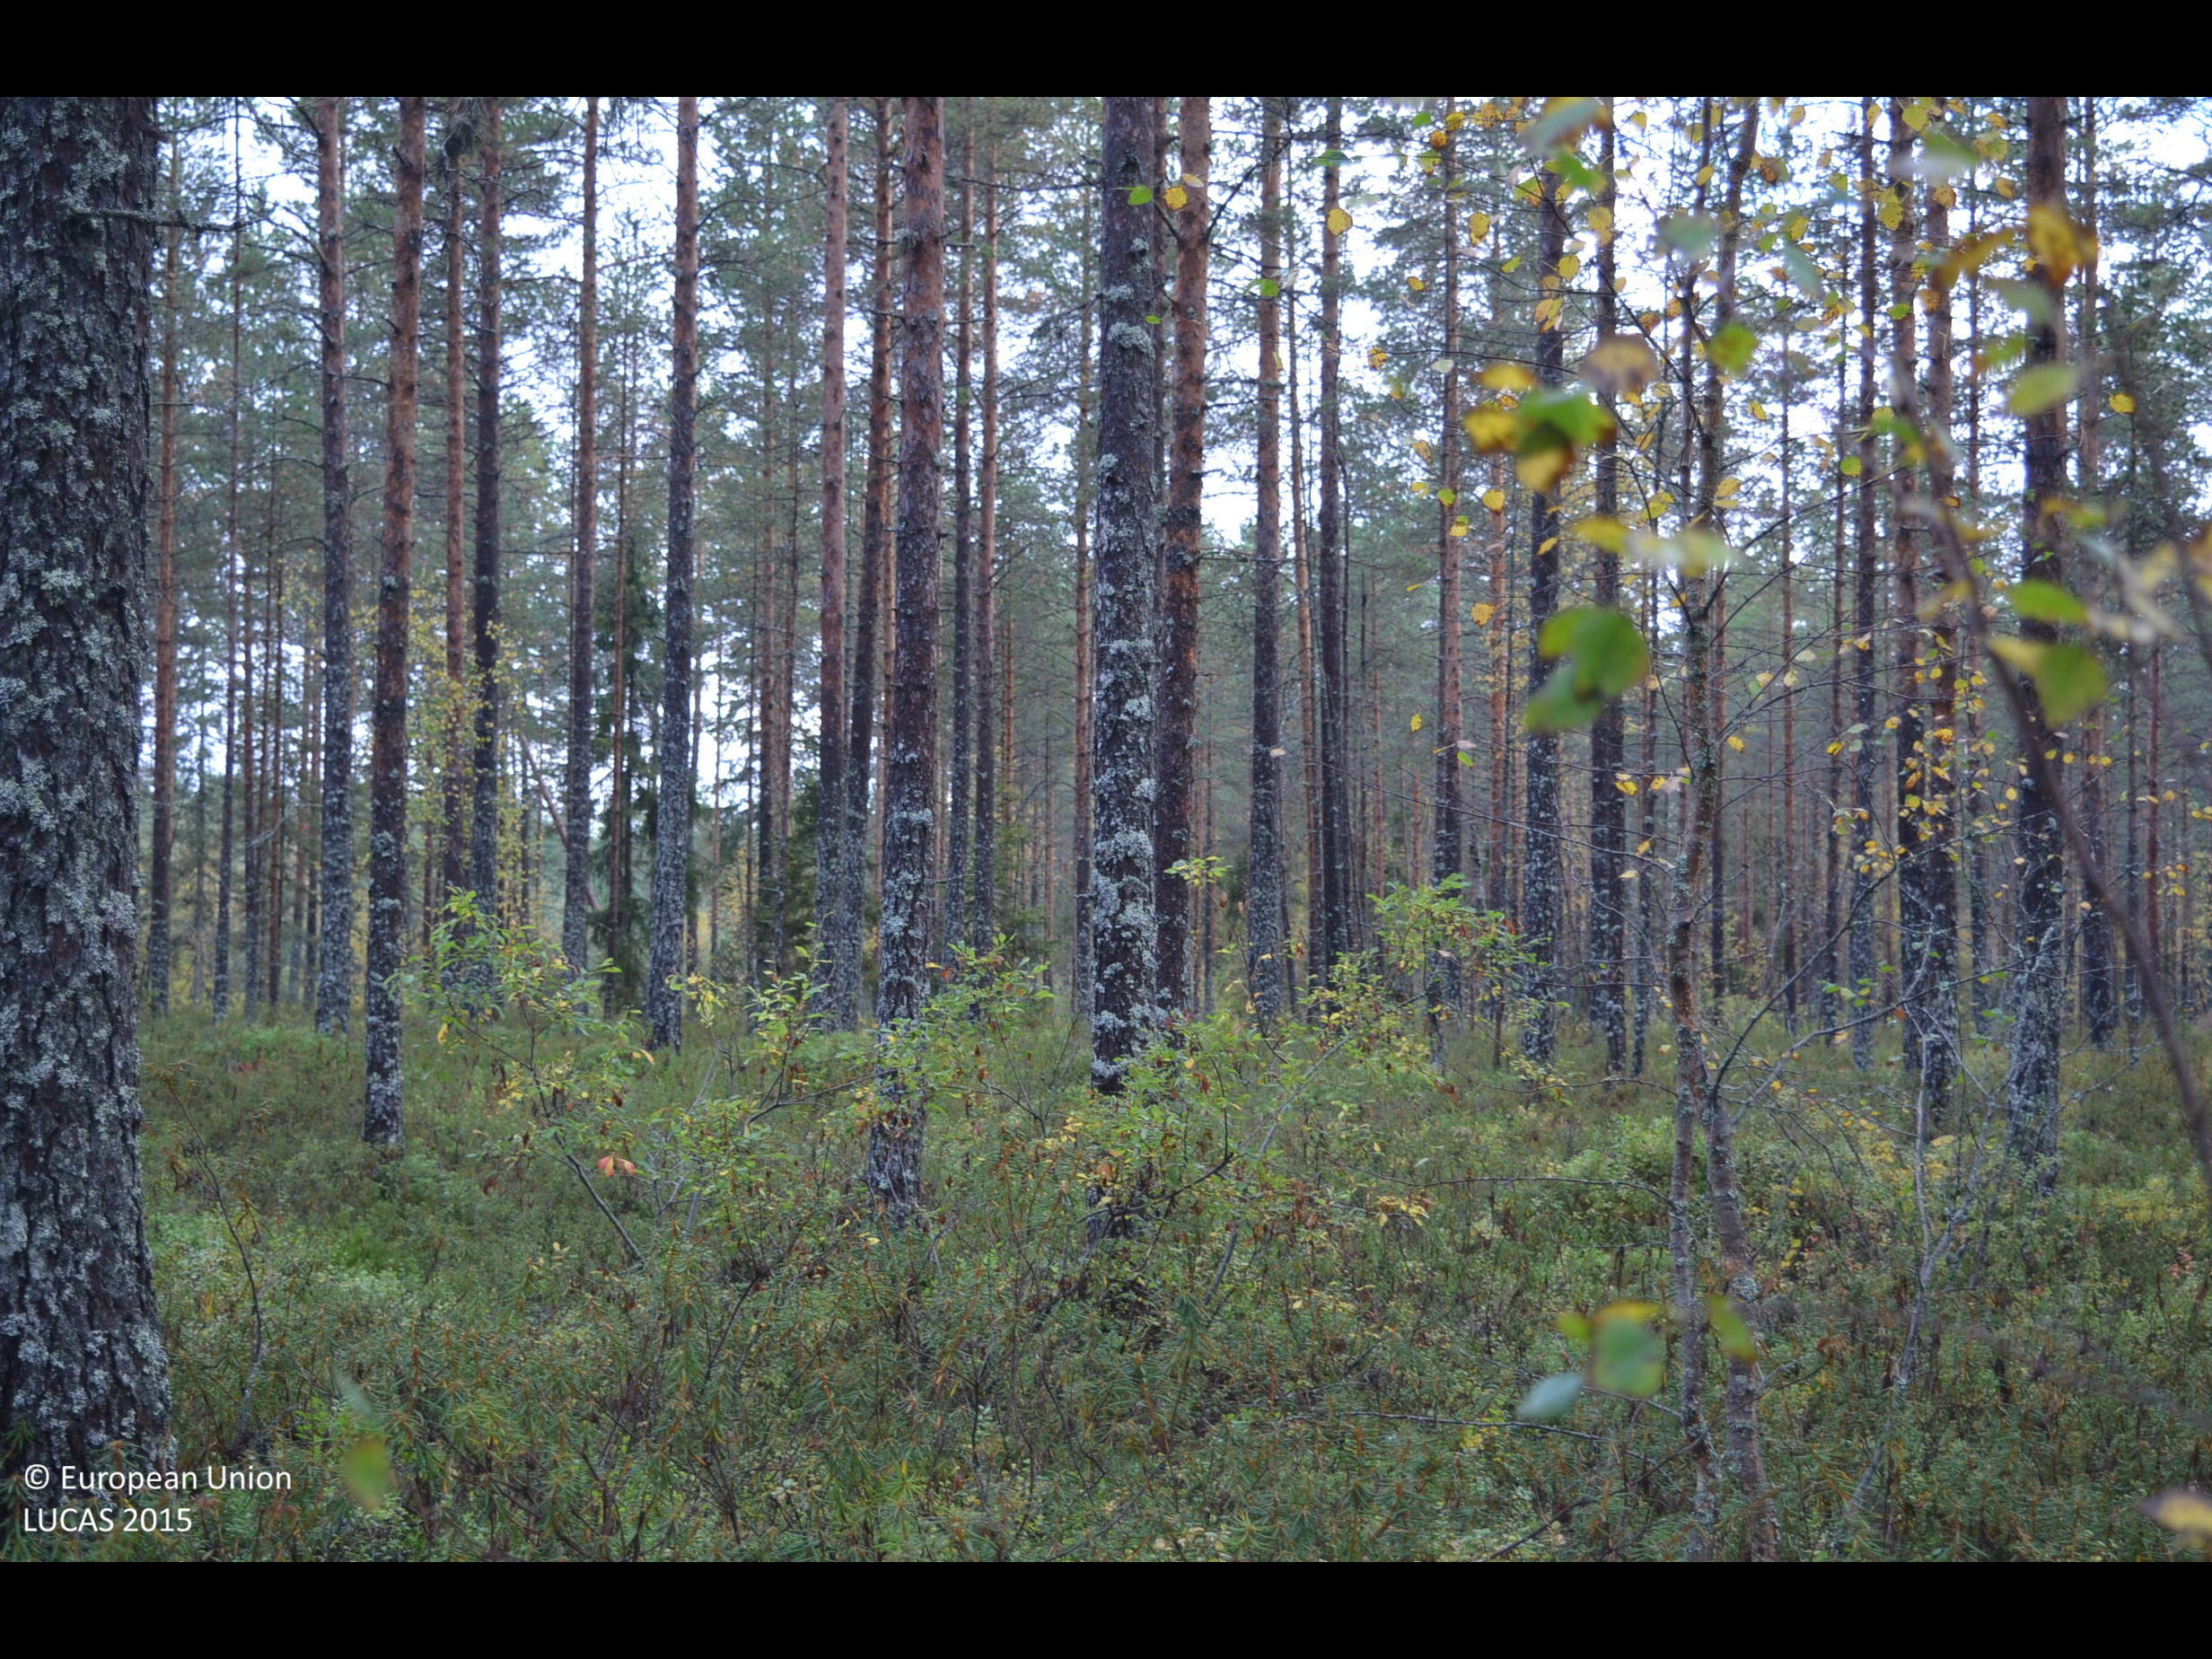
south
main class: Woodland
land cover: Pine dominated mixed woodland
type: boreal forest
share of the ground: > 75 %
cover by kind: coniferous forest trees 55 %, shrubs 25 %, broadleaved forest trees 20 %
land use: Forestry
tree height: > 5 m
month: September
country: FI
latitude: 62.9135
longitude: 23.9536
